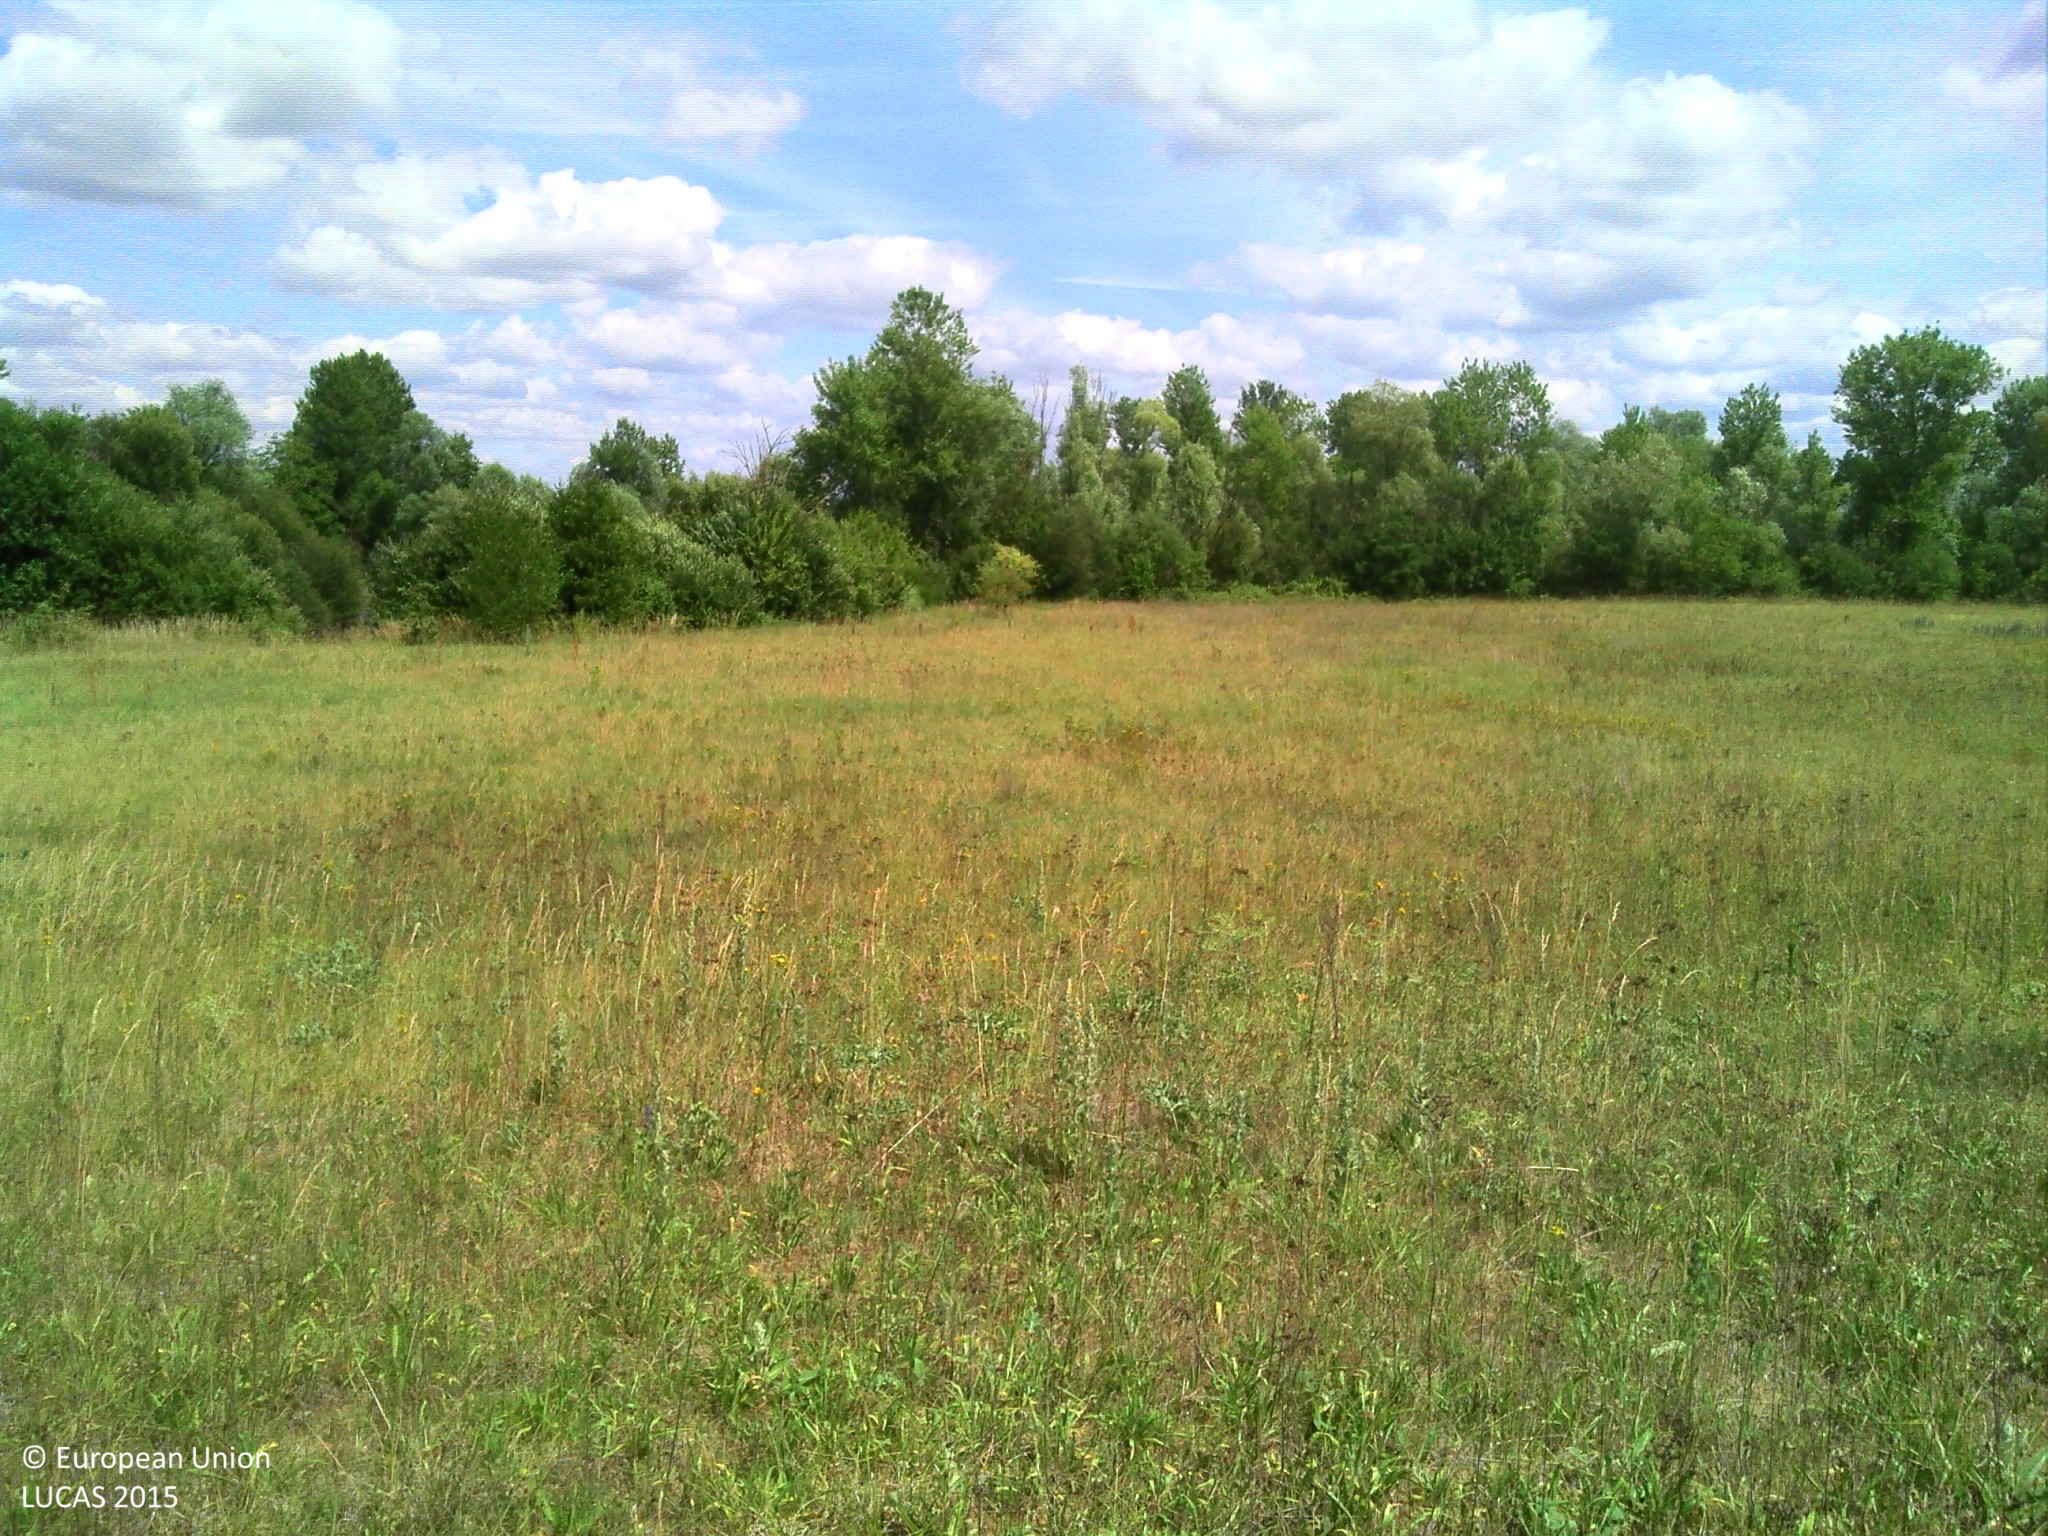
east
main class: Grassland
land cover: Grassland without tree/shrub cover
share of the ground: > 75 %
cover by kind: herbaceous plants 100 %
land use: Agriculture (excluding fallow land and kitchen gardens)
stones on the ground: < 10 %
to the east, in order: Grassland without tree/shrub cover; Fences; Broadleaved woodland; Barley; Lucerne
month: June
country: FR
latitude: 47.4334
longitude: 0.3117
